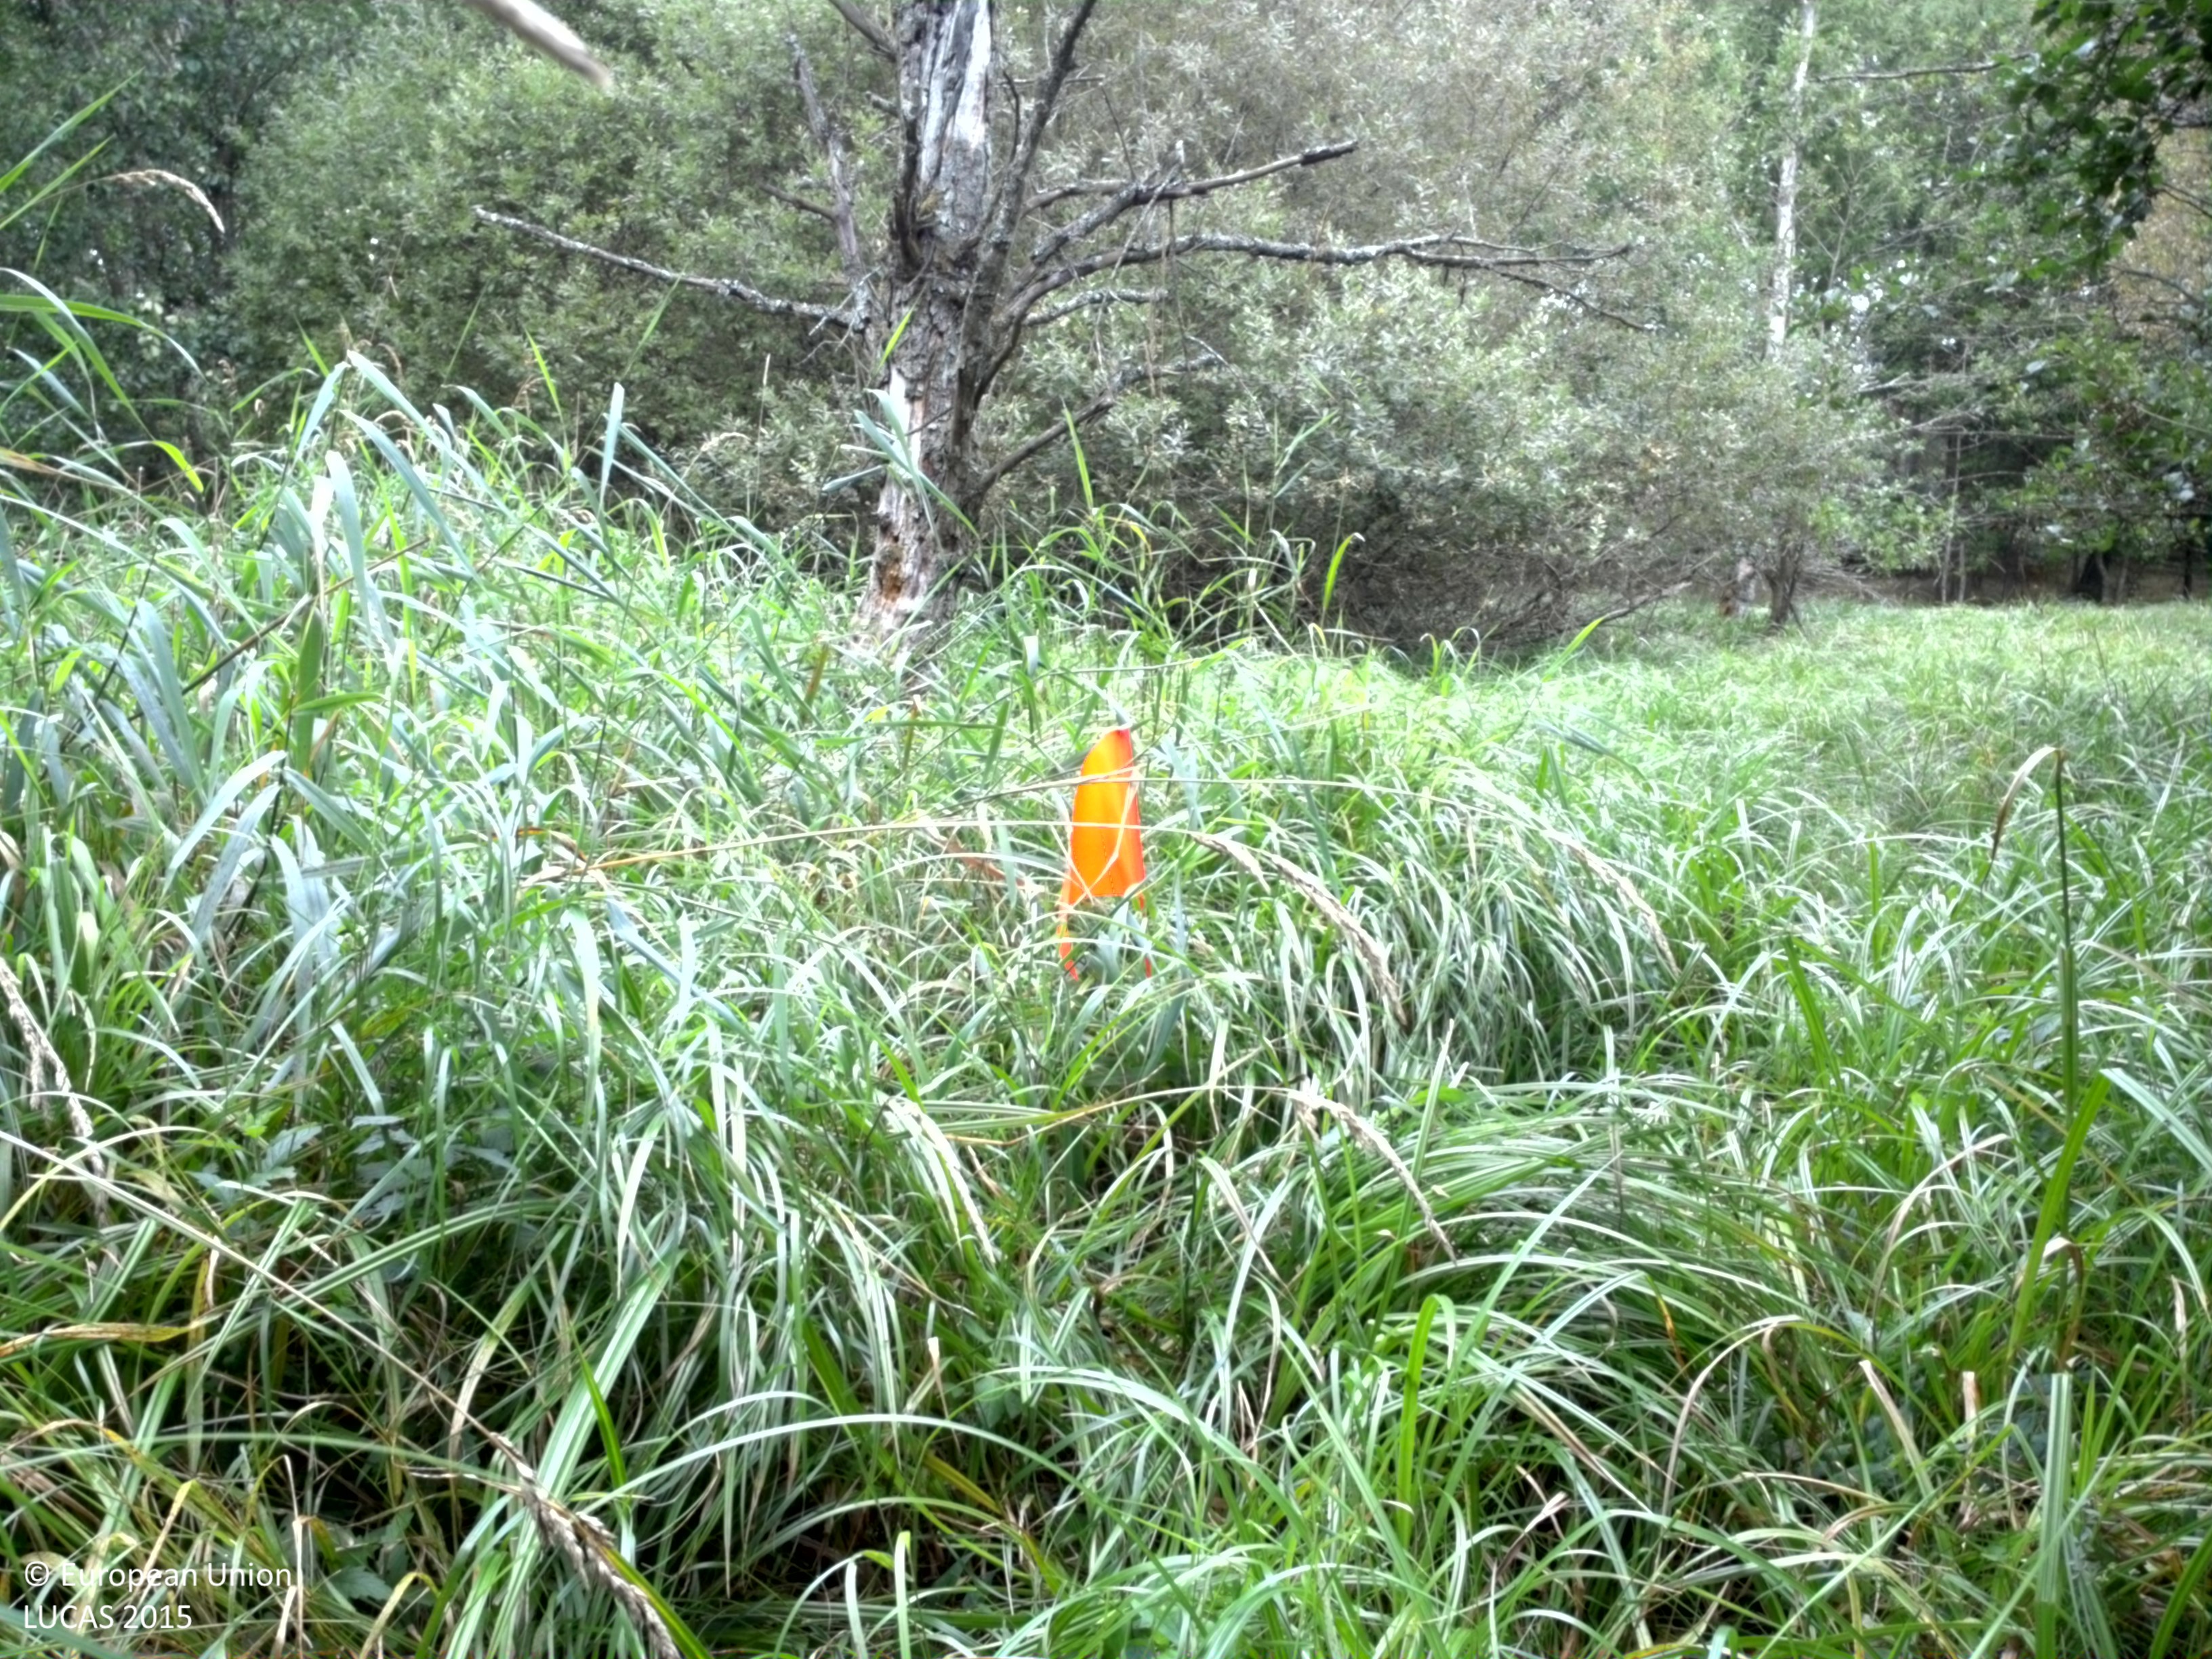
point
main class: Woodland
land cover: Broadleaved woodland
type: mesophytic deciduous forest
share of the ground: 25 - 50 %
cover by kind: herbaceous plants 50 %, broadleaved forest trees 40 %, shrubs 10 %
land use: Forestry
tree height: < 5 m
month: September
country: SE
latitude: 55.5409
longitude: 13.6906
